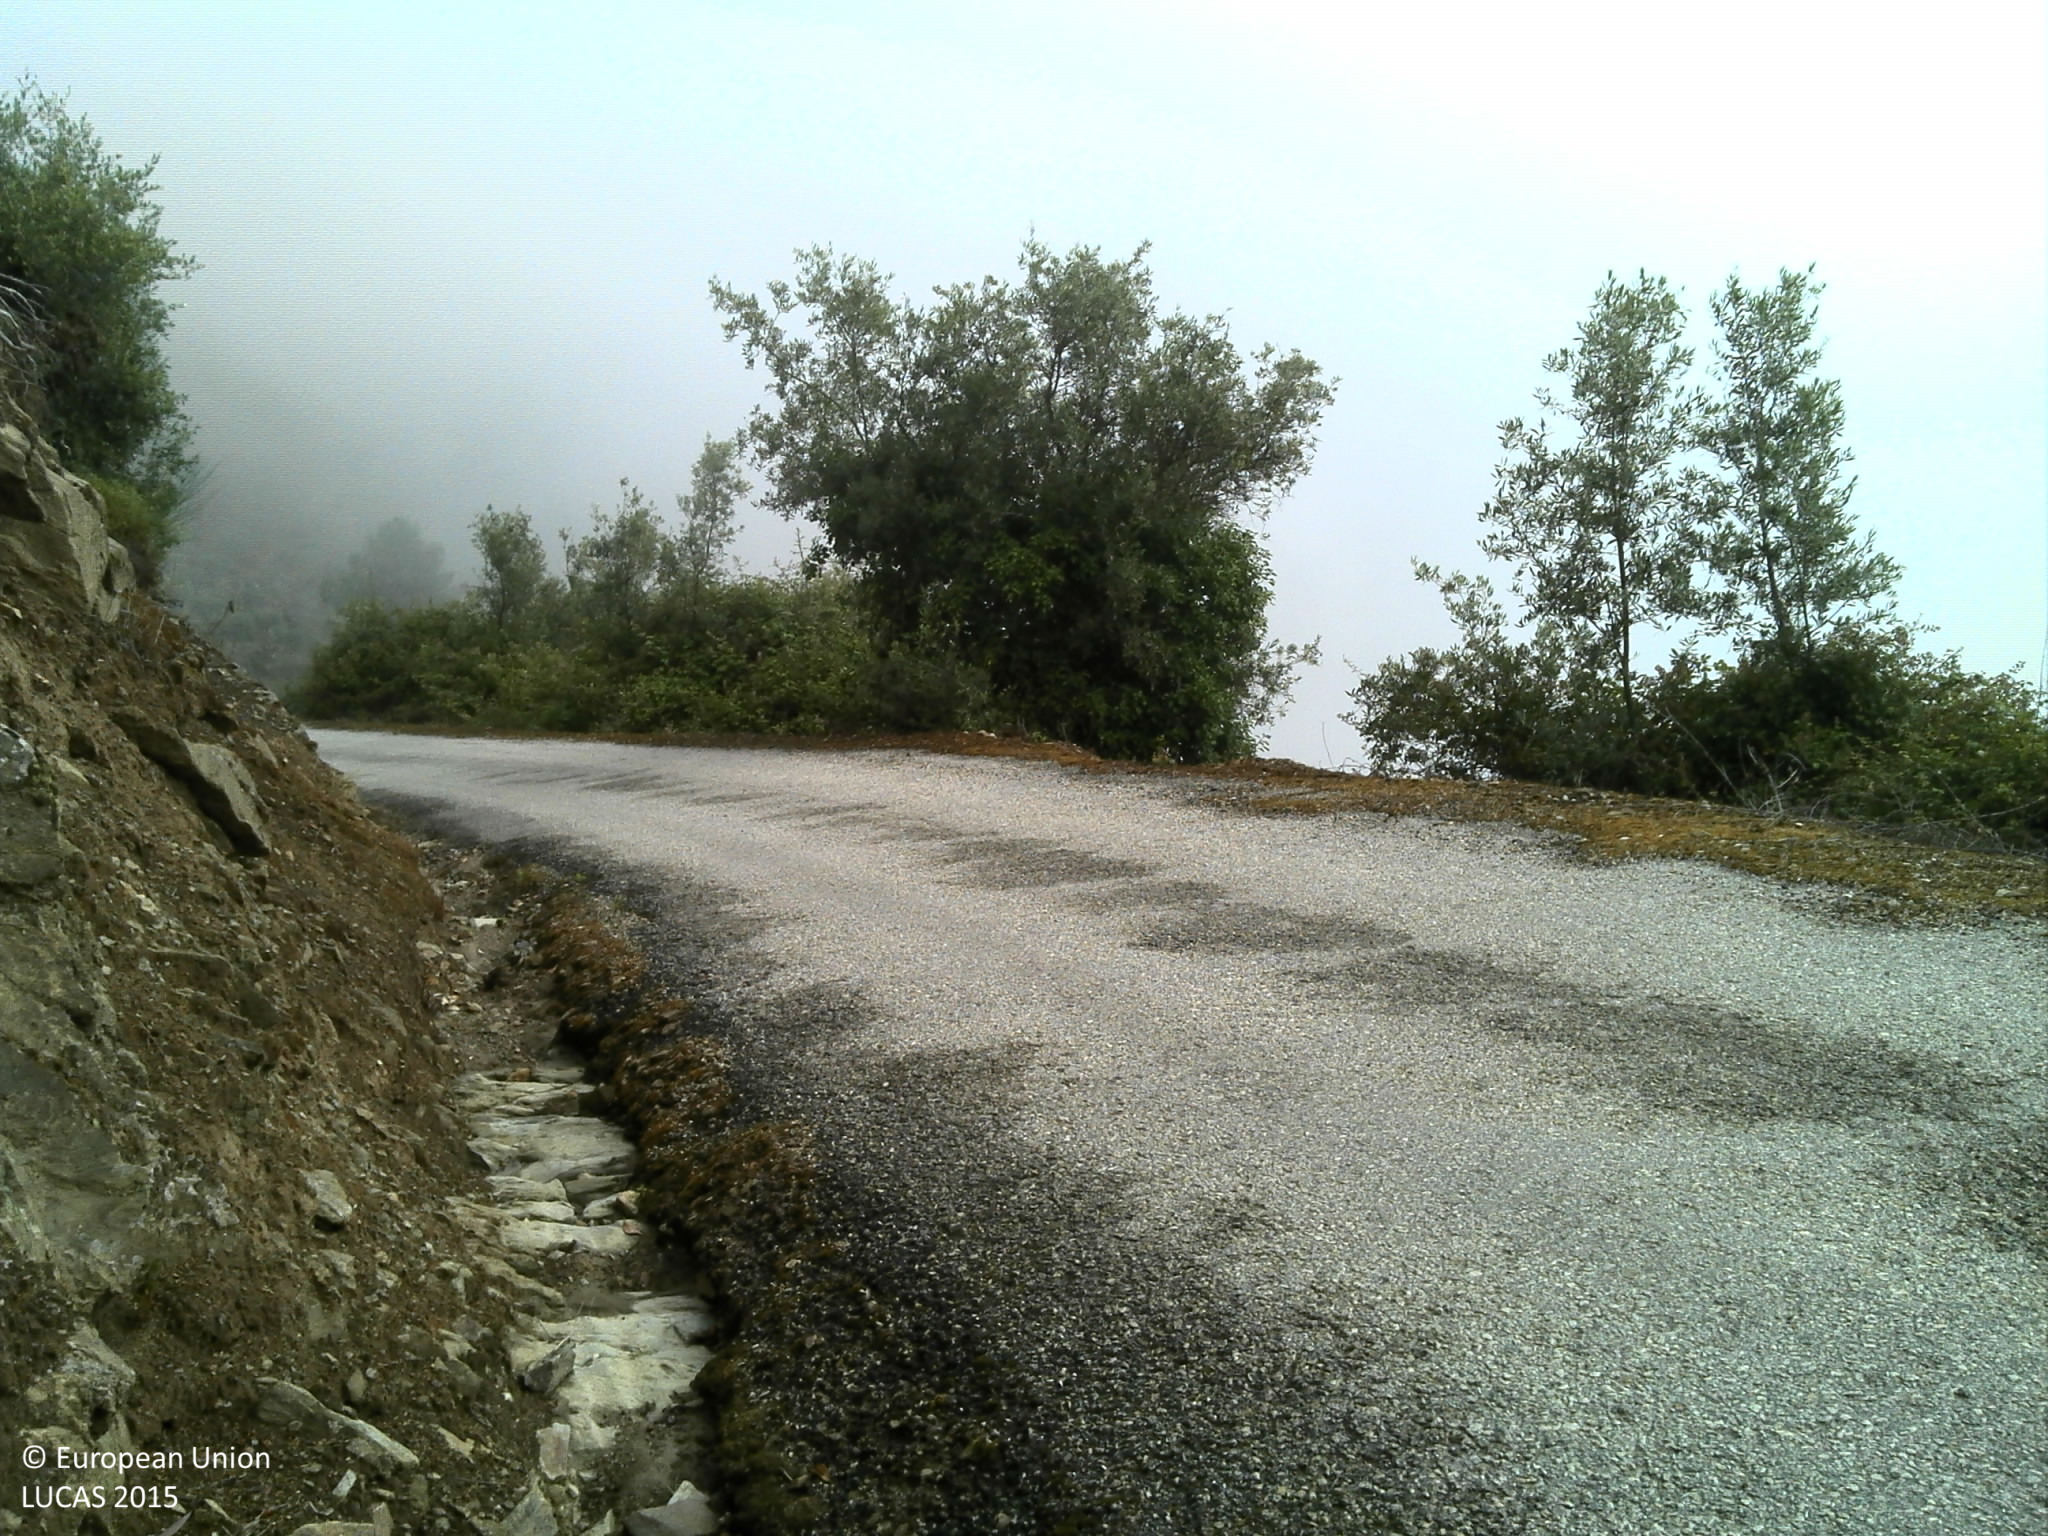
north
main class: Cropland
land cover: Olive groves
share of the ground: < 10 %
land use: Agriculture (excluding fallow land and kitchen gardens)
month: June
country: PT
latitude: 41.1220
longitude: -7.5719
